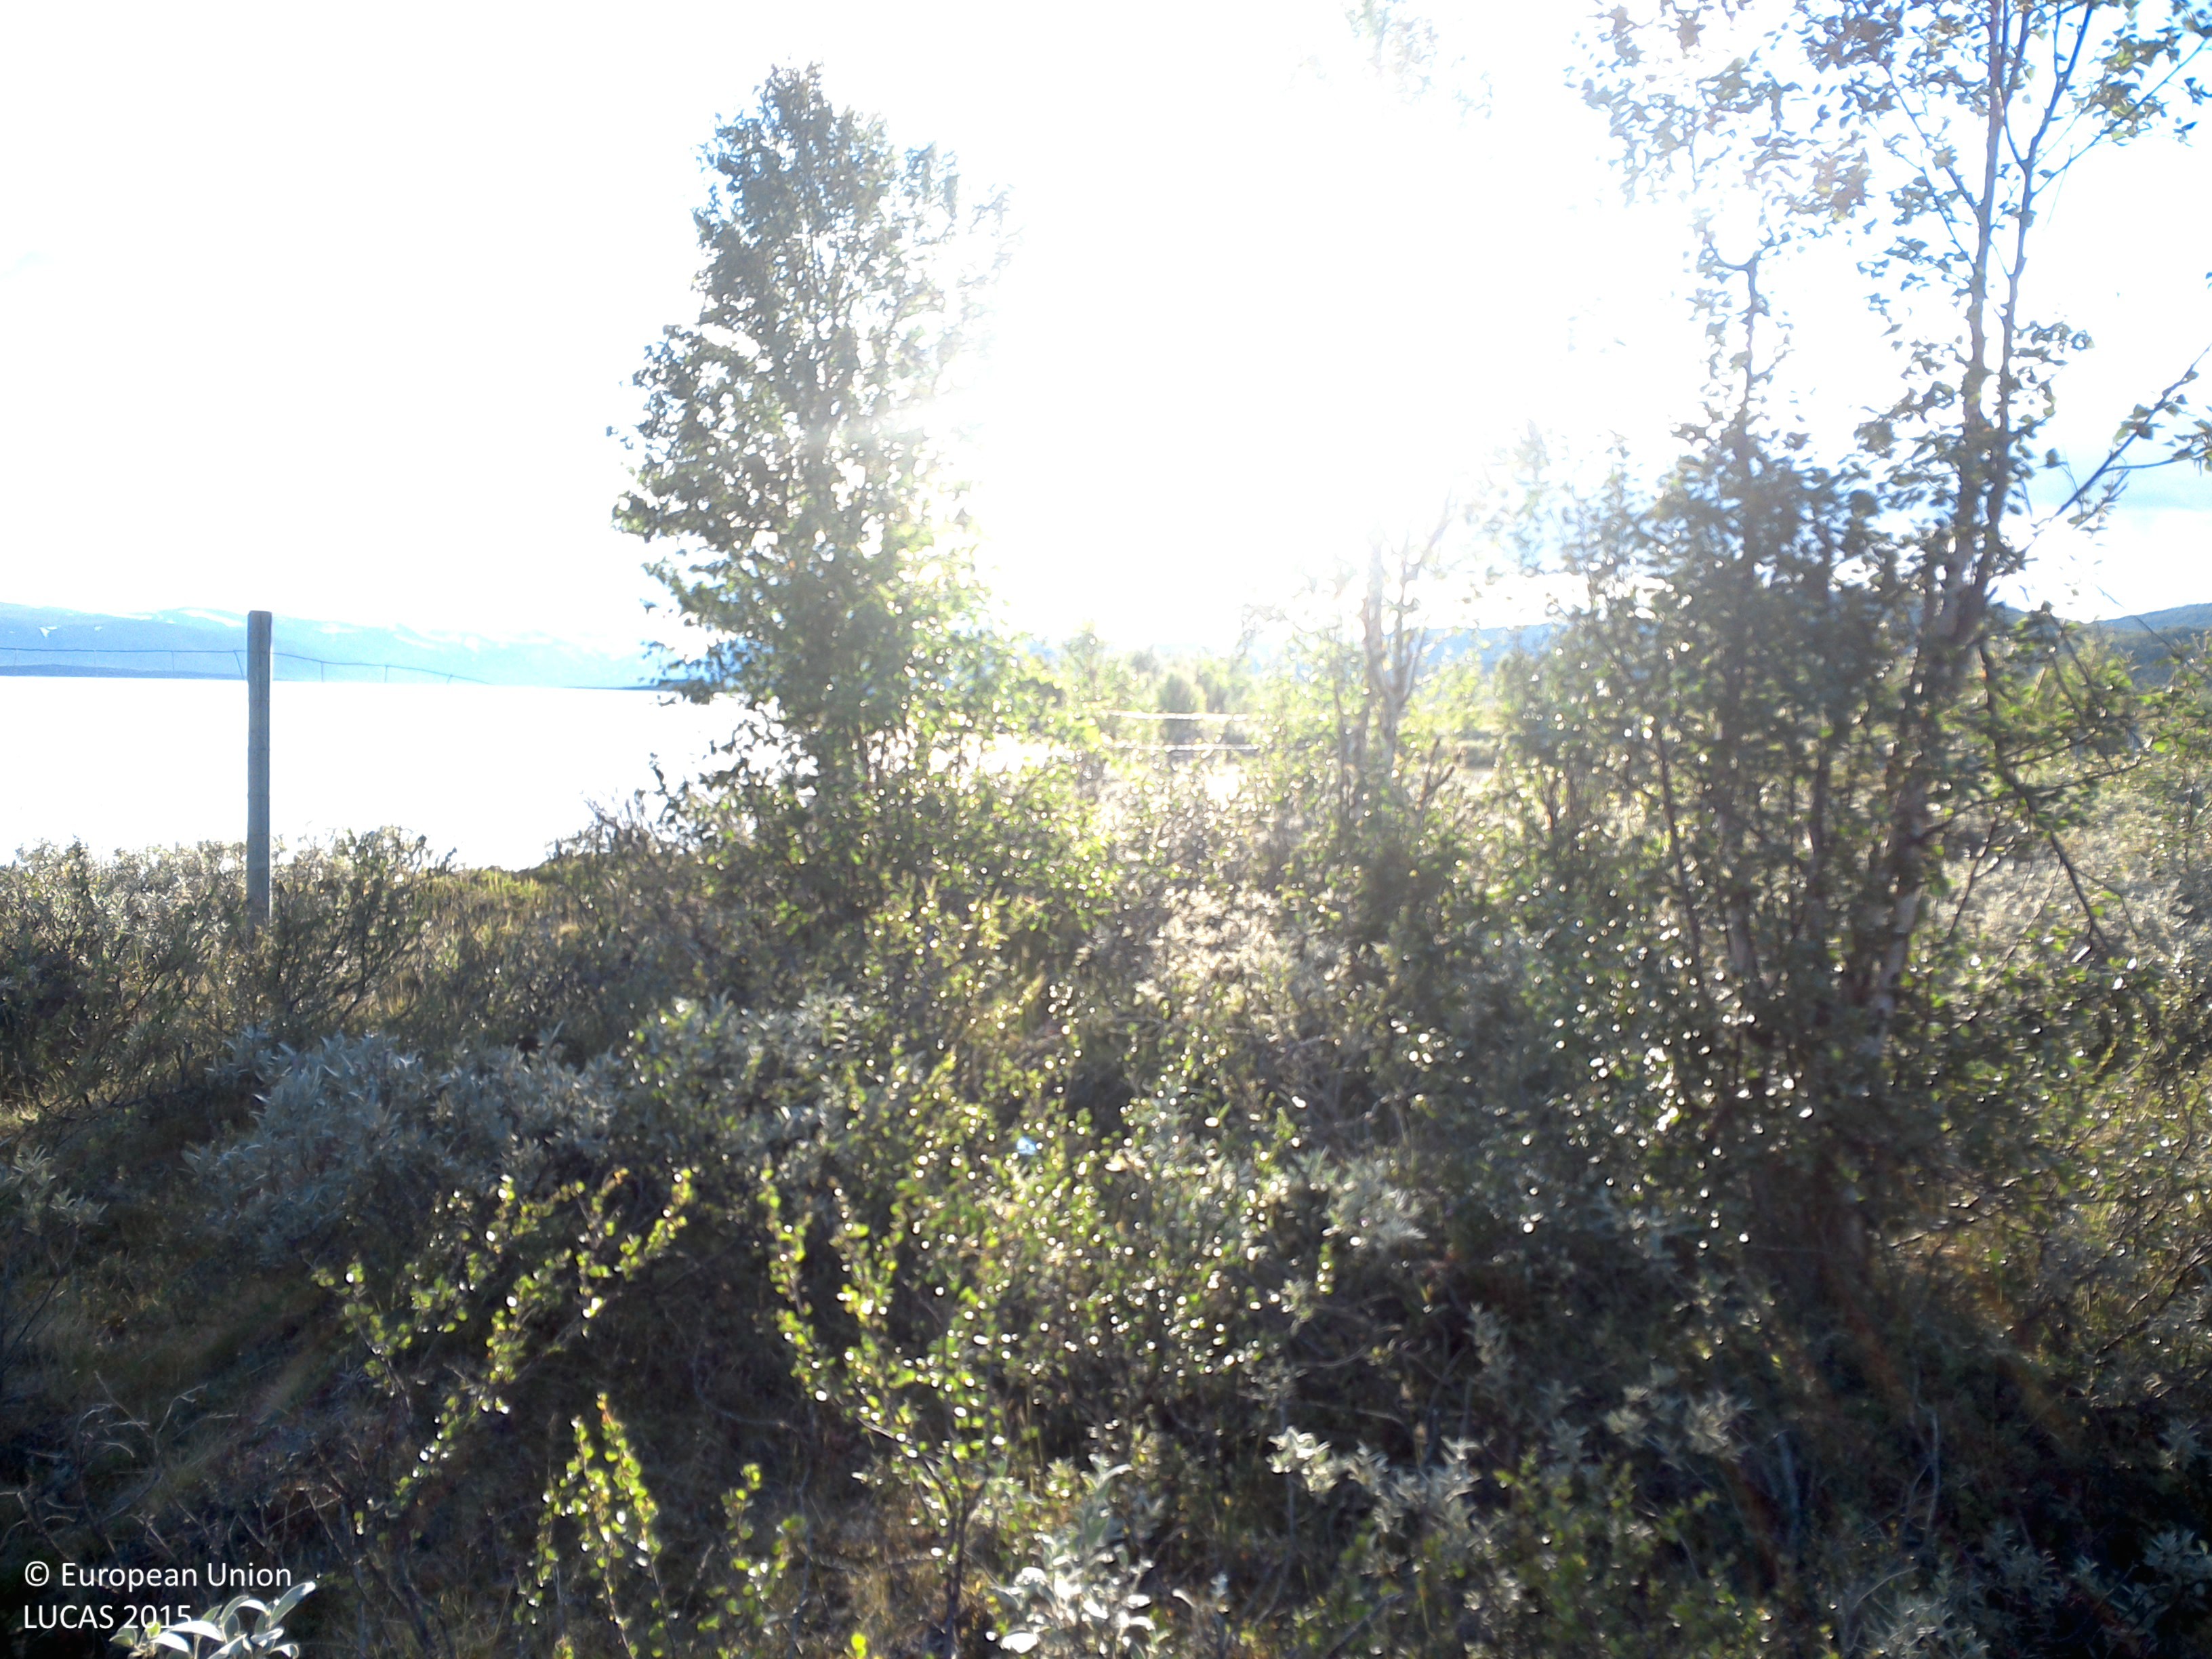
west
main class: Shrubland
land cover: Shrubland with sparse tree cover
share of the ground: > 75 %
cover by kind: shrubs 95 %, broadleaved forest trees 5 %
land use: Semi-natural and natural areas not in use
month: August
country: SE
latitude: 67.8599
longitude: 19.3770
